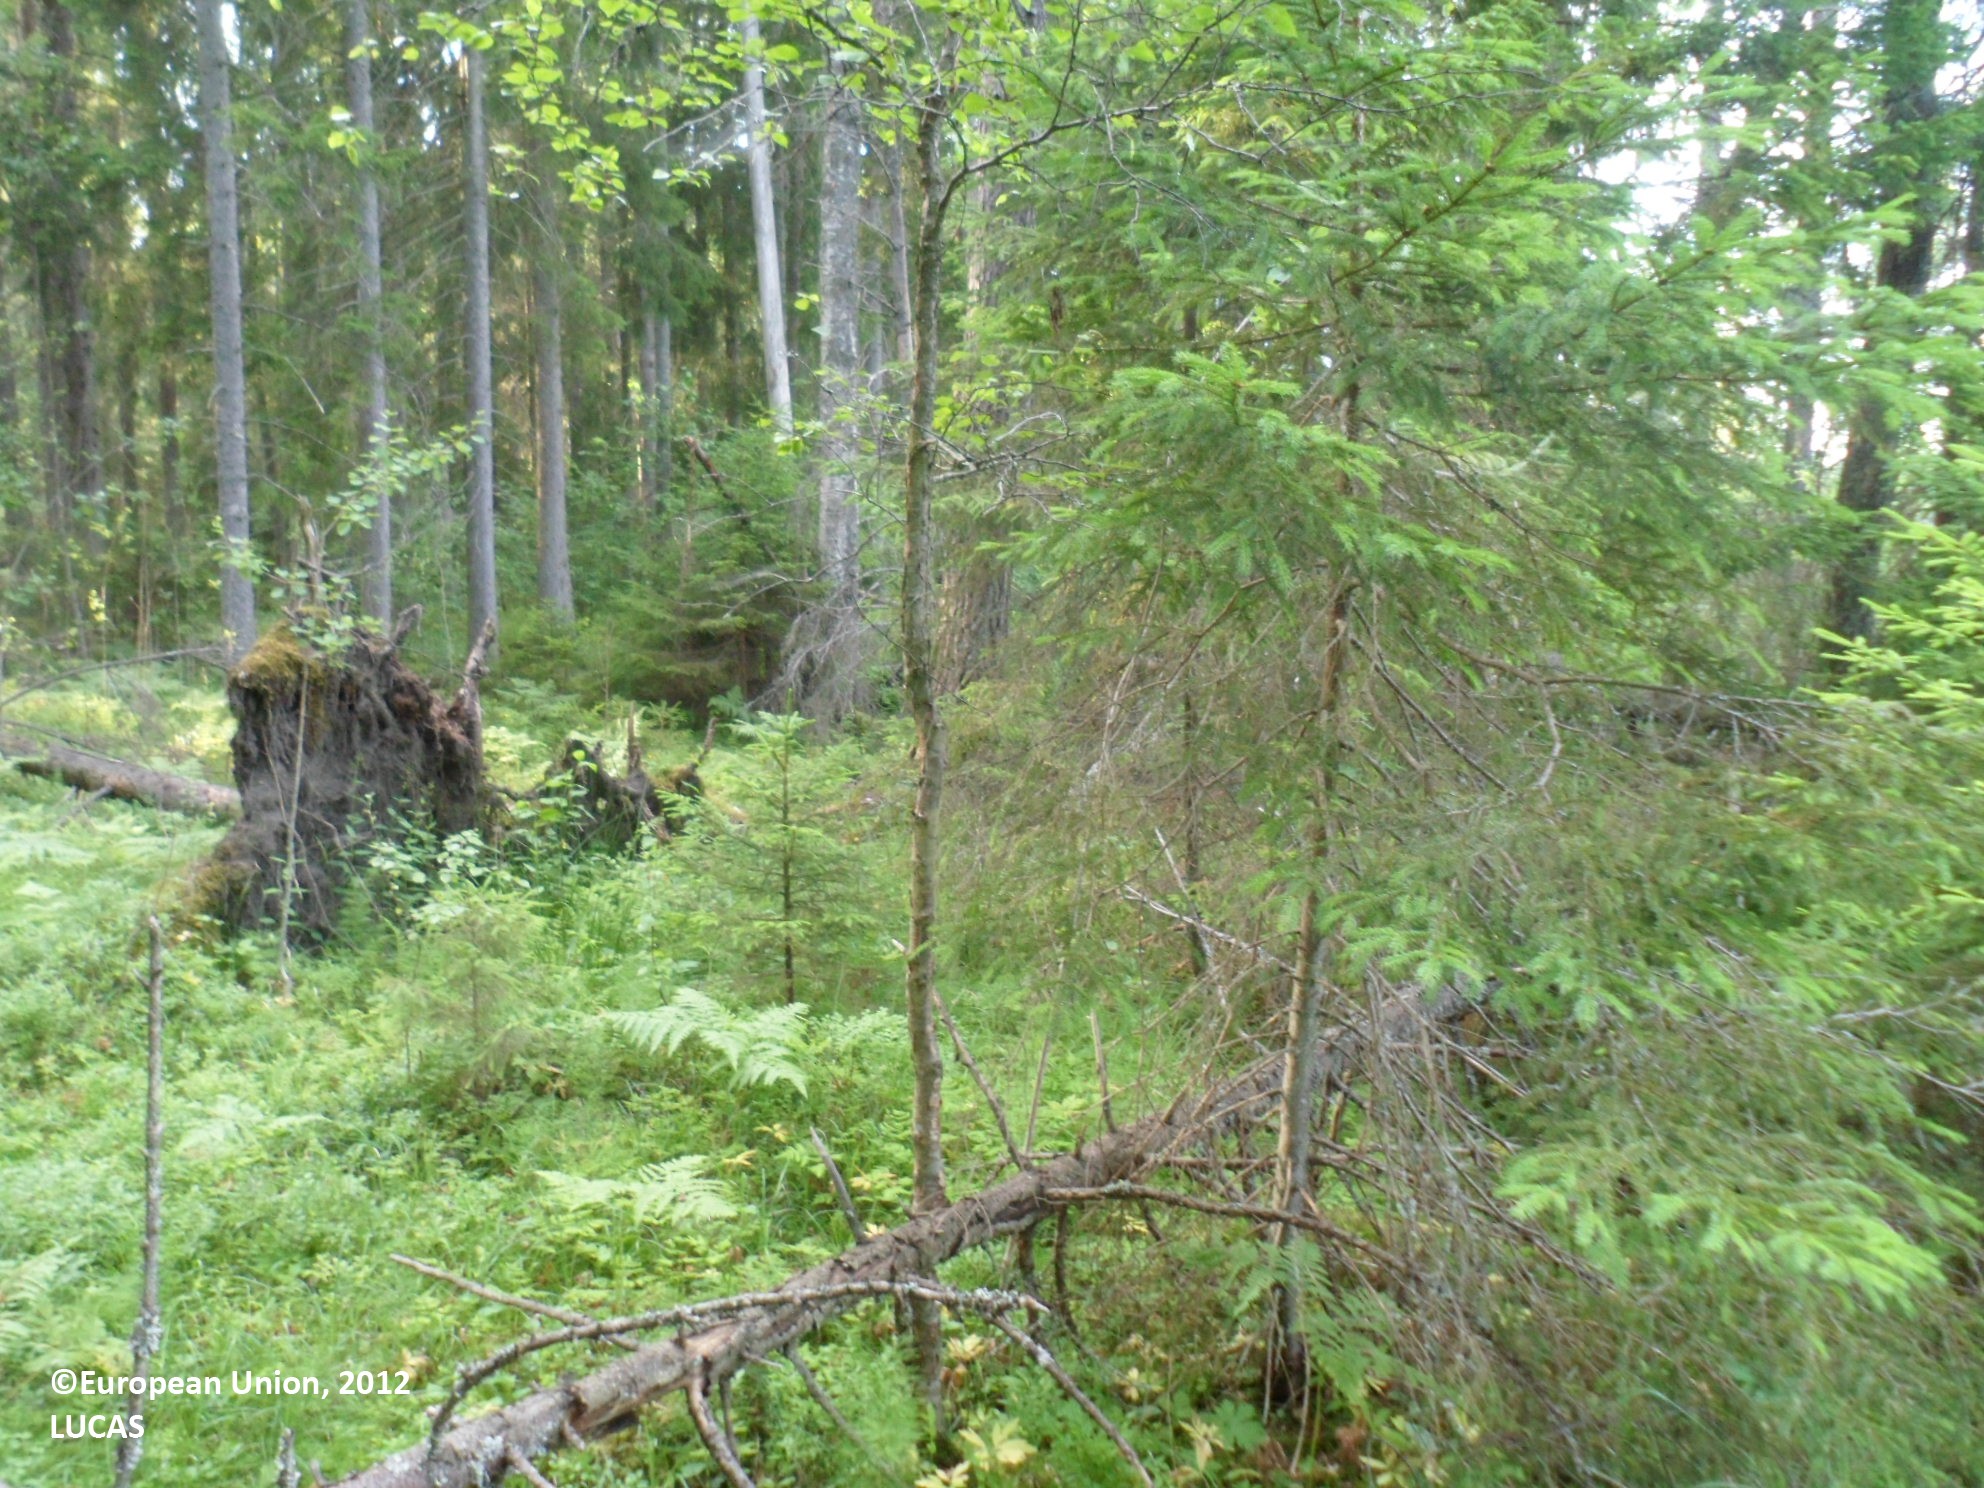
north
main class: Woodland
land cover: Spruce dominated coniferous woodland
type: boreal forest
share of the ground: > 75 %
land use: Forestry
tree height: > 5 m
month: July
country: SE
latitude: 59.6457
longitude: 18.6043
